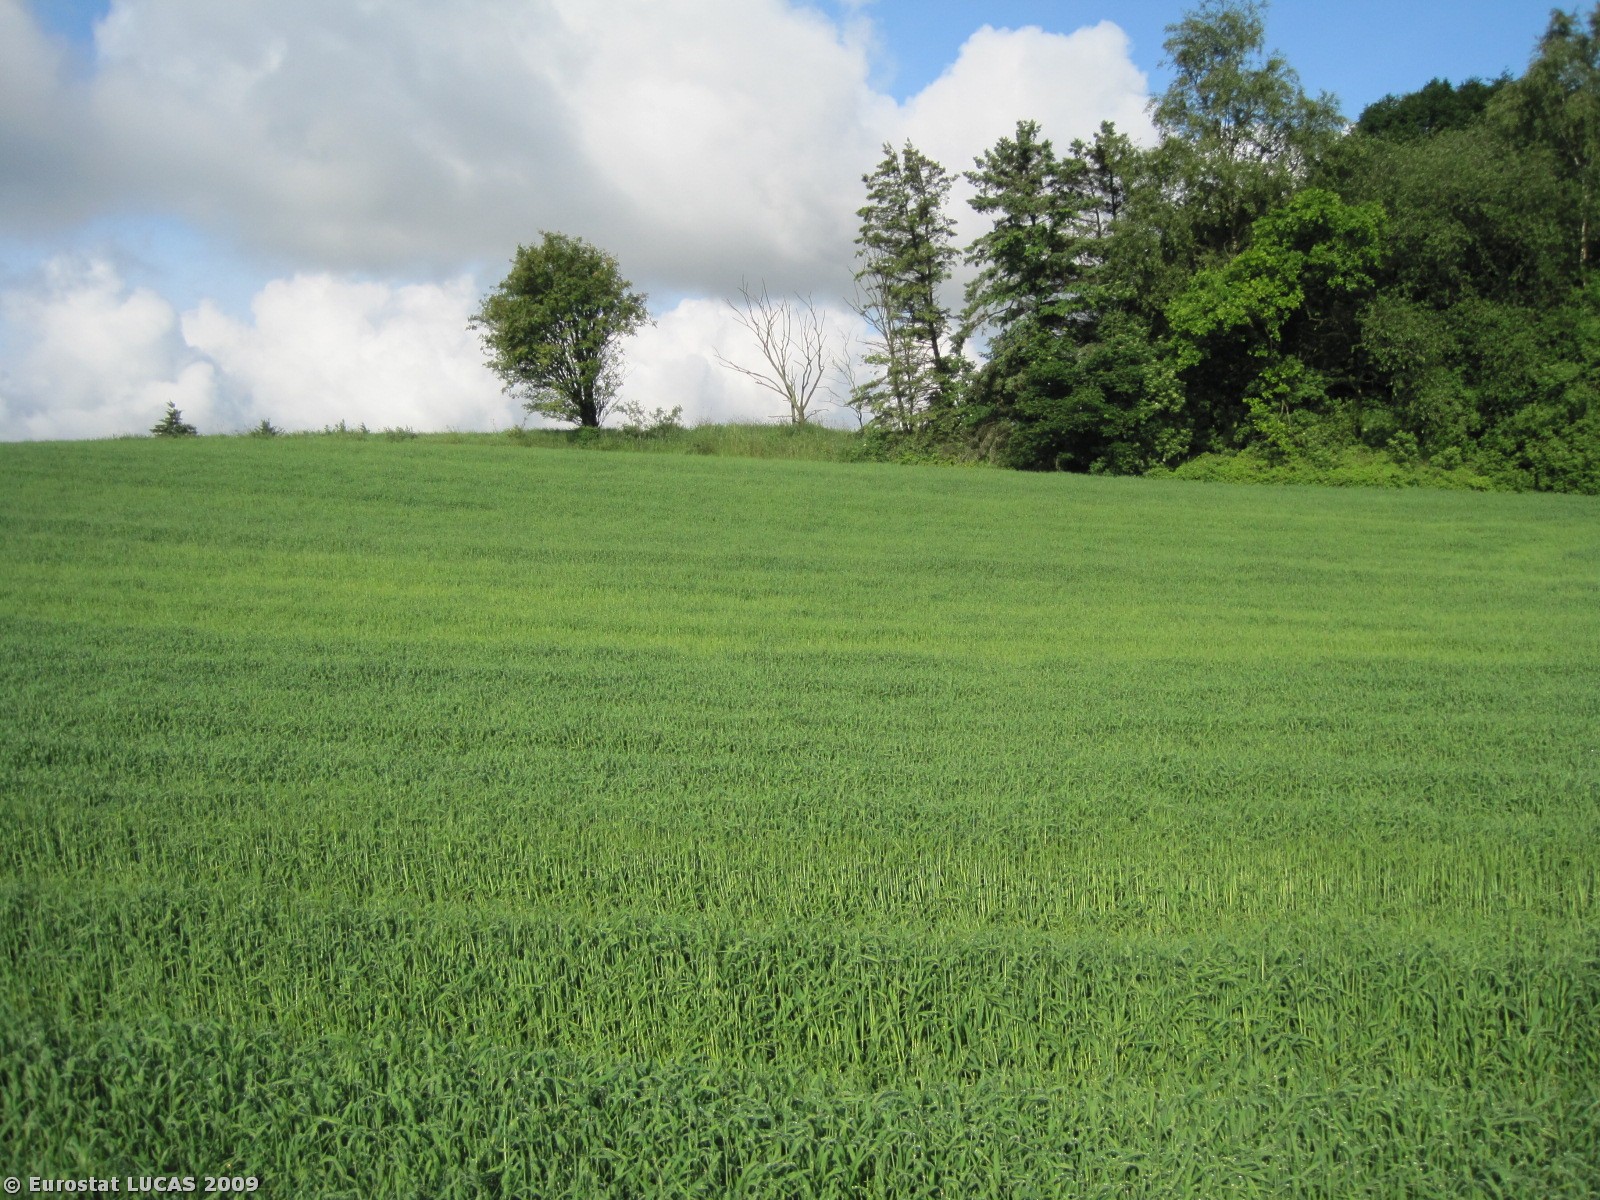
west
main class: Cropland
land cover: Barley
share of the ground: > 75 %
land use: Agriculture (excluding fallow land and kitchen gardens)
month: June
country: DK
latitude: 57.2842
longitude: 10.1822
